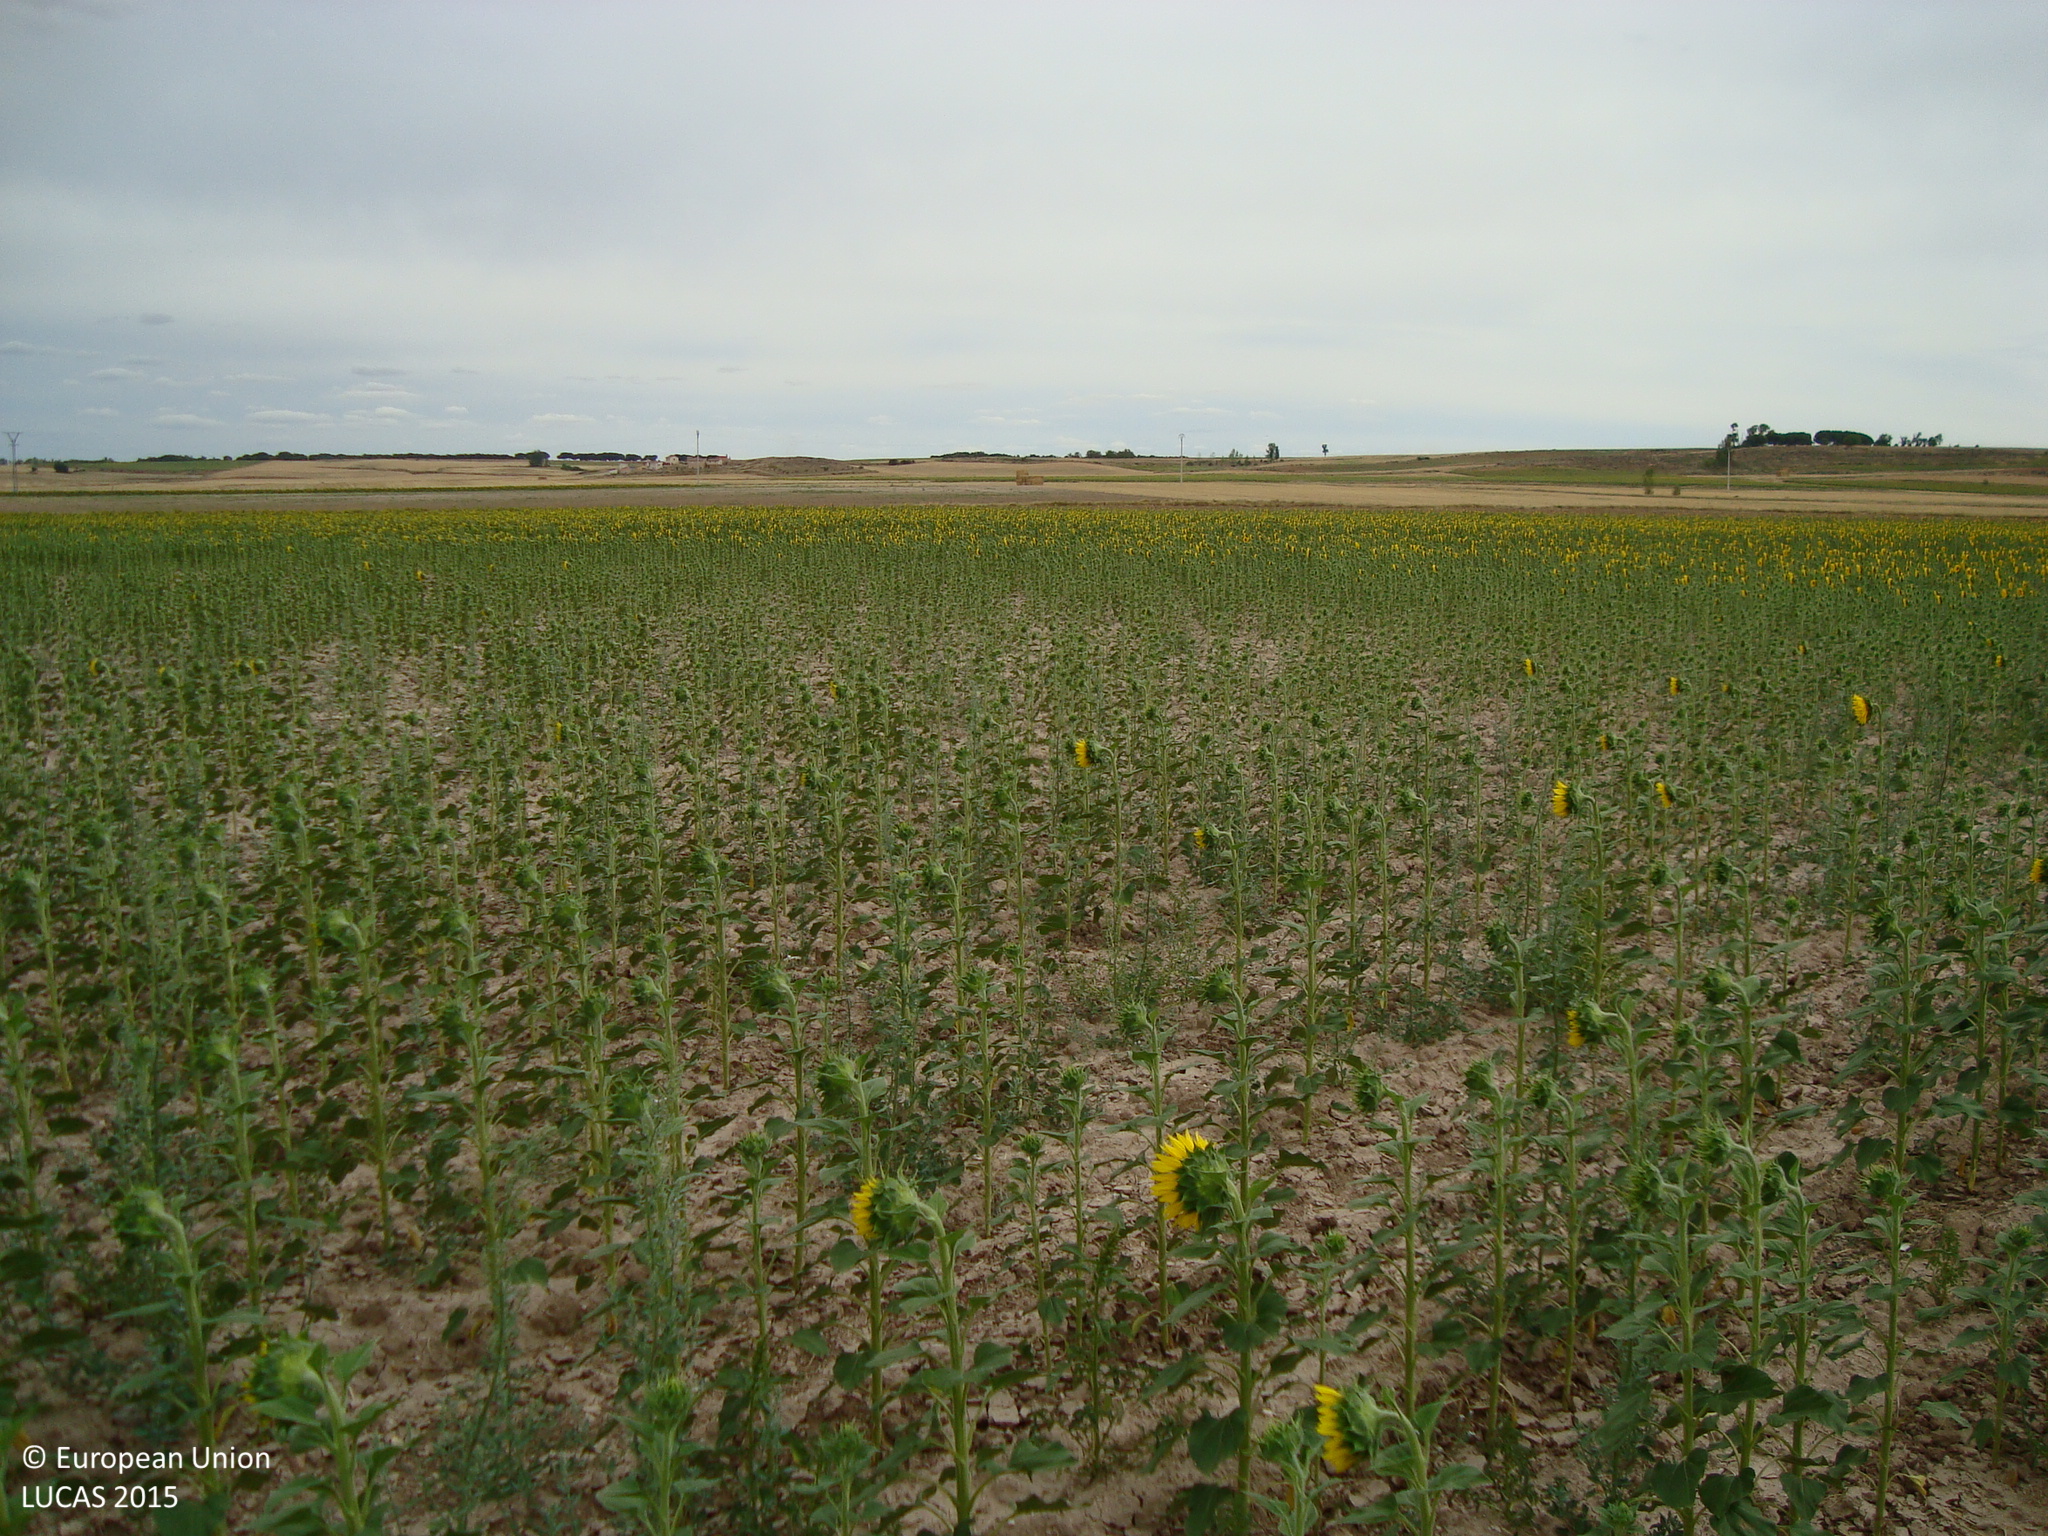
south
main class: Cropland
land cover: Sunflower
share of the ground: 50 - 75 %
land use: Agriculture (excluding fallow land and kitchen gardens)
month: August
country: ES
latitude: 42.1599
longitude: -3.9446
